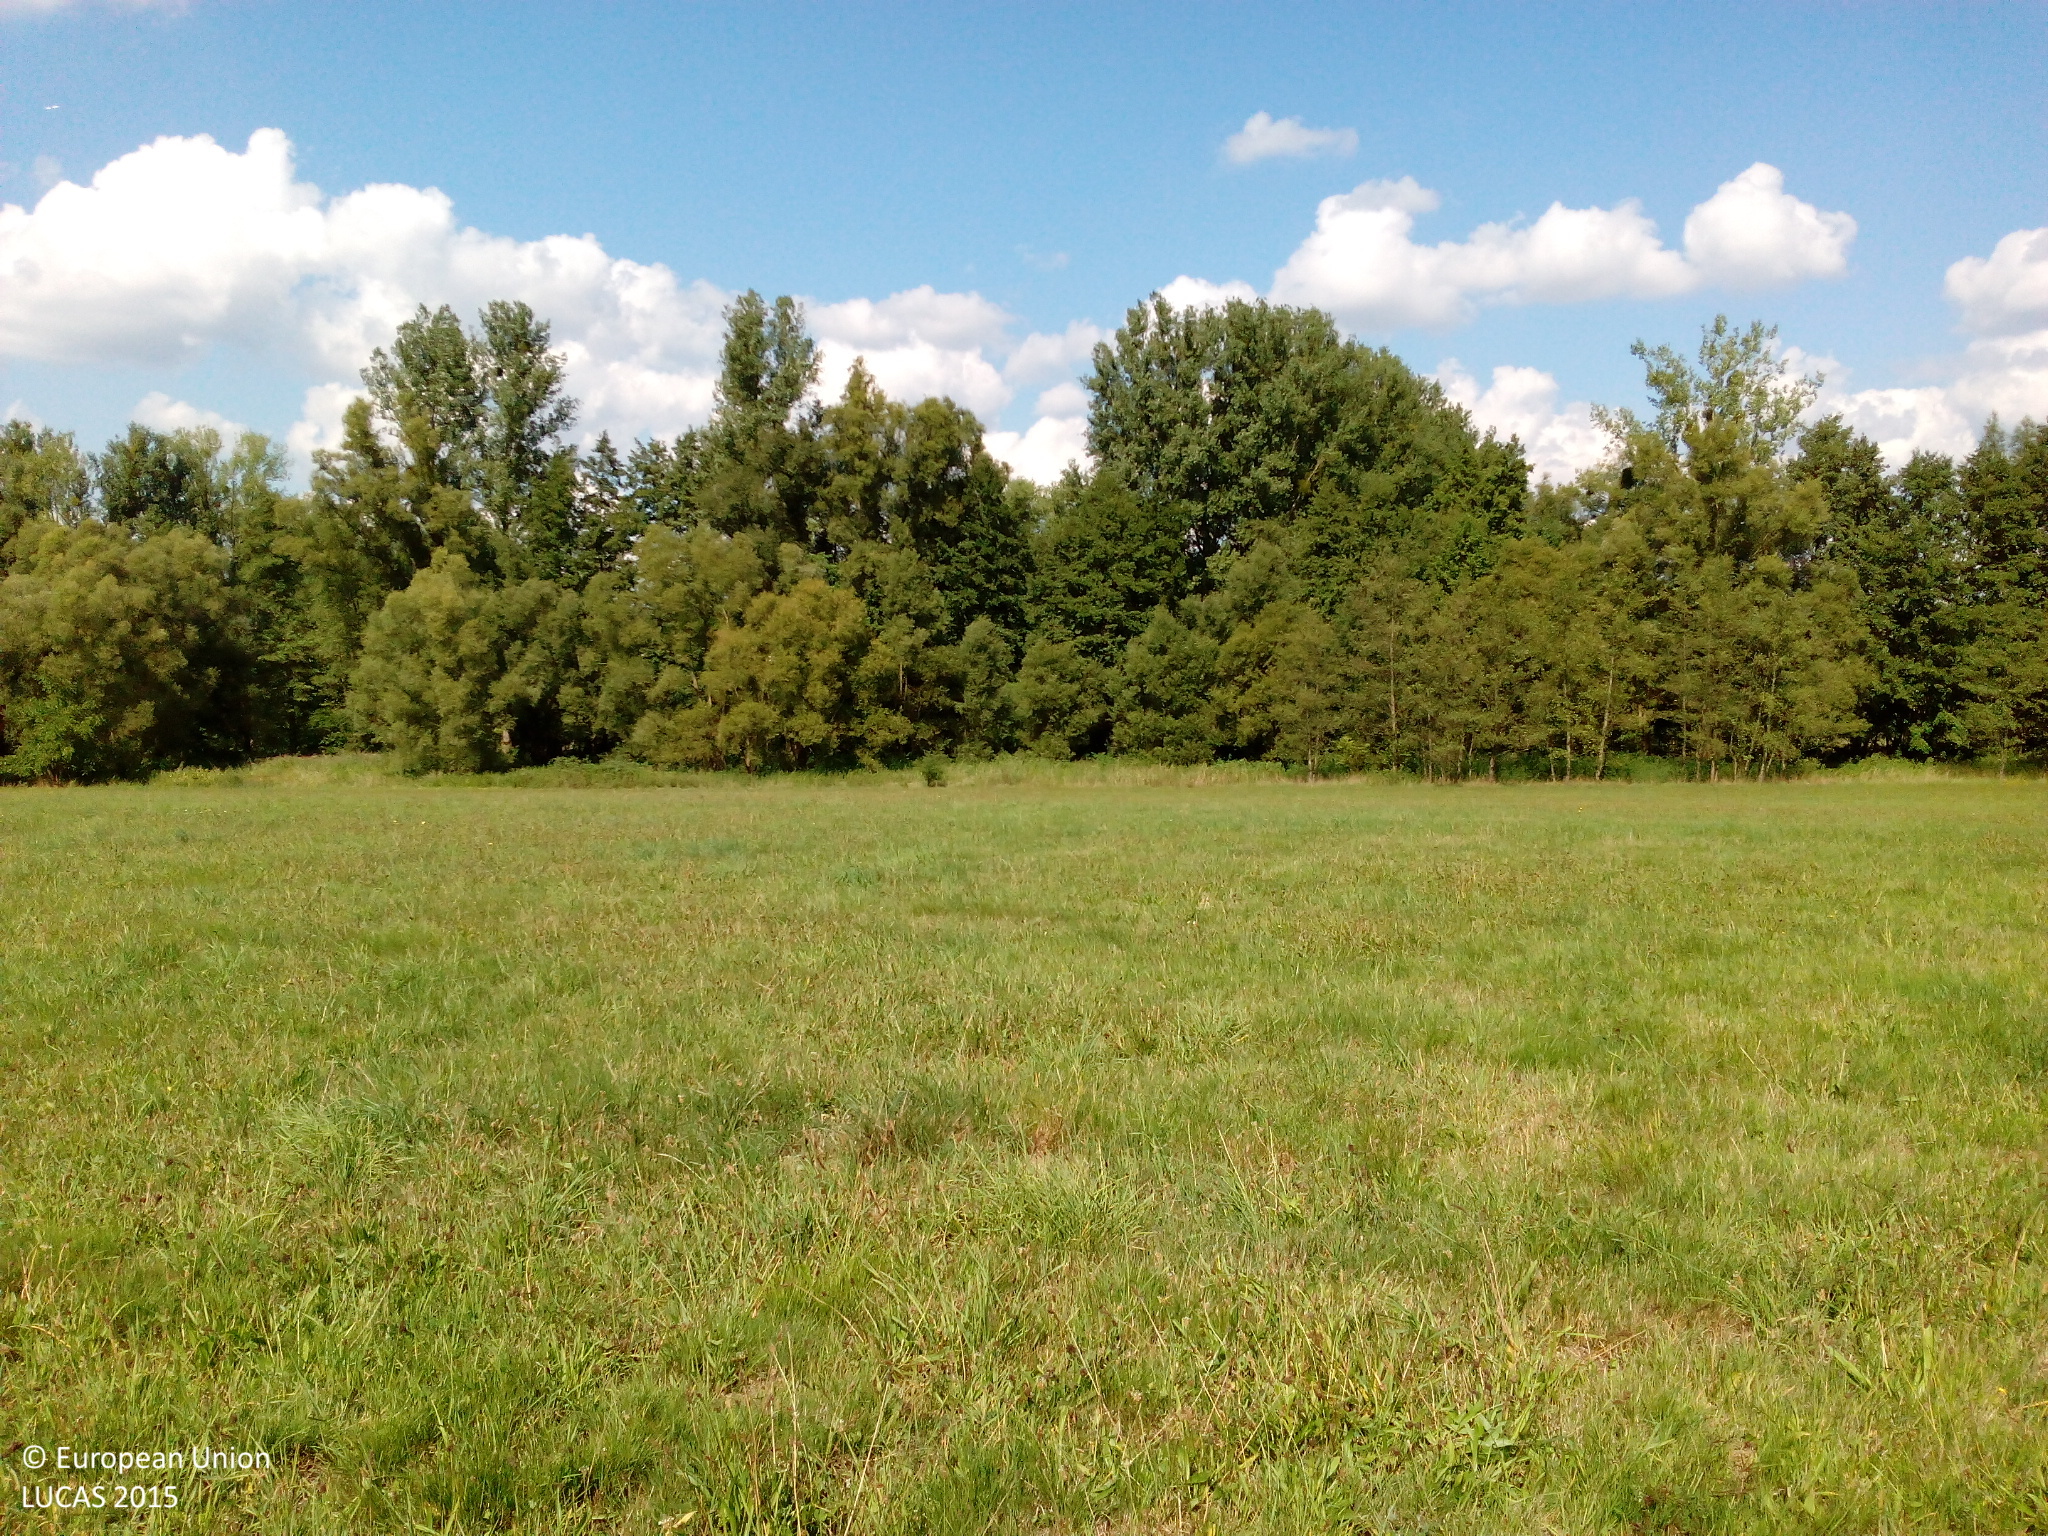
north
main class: Grassland
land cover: Grassland without tree/shrub cover
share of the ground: > 75 %
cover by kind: herbaceous plants 95 %, unconsolidated bare surface 5 %
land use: Agriculture (excluding fallow land and kitchen gardens)
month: September
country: DE
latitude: 49.9834
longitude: 9.1774
